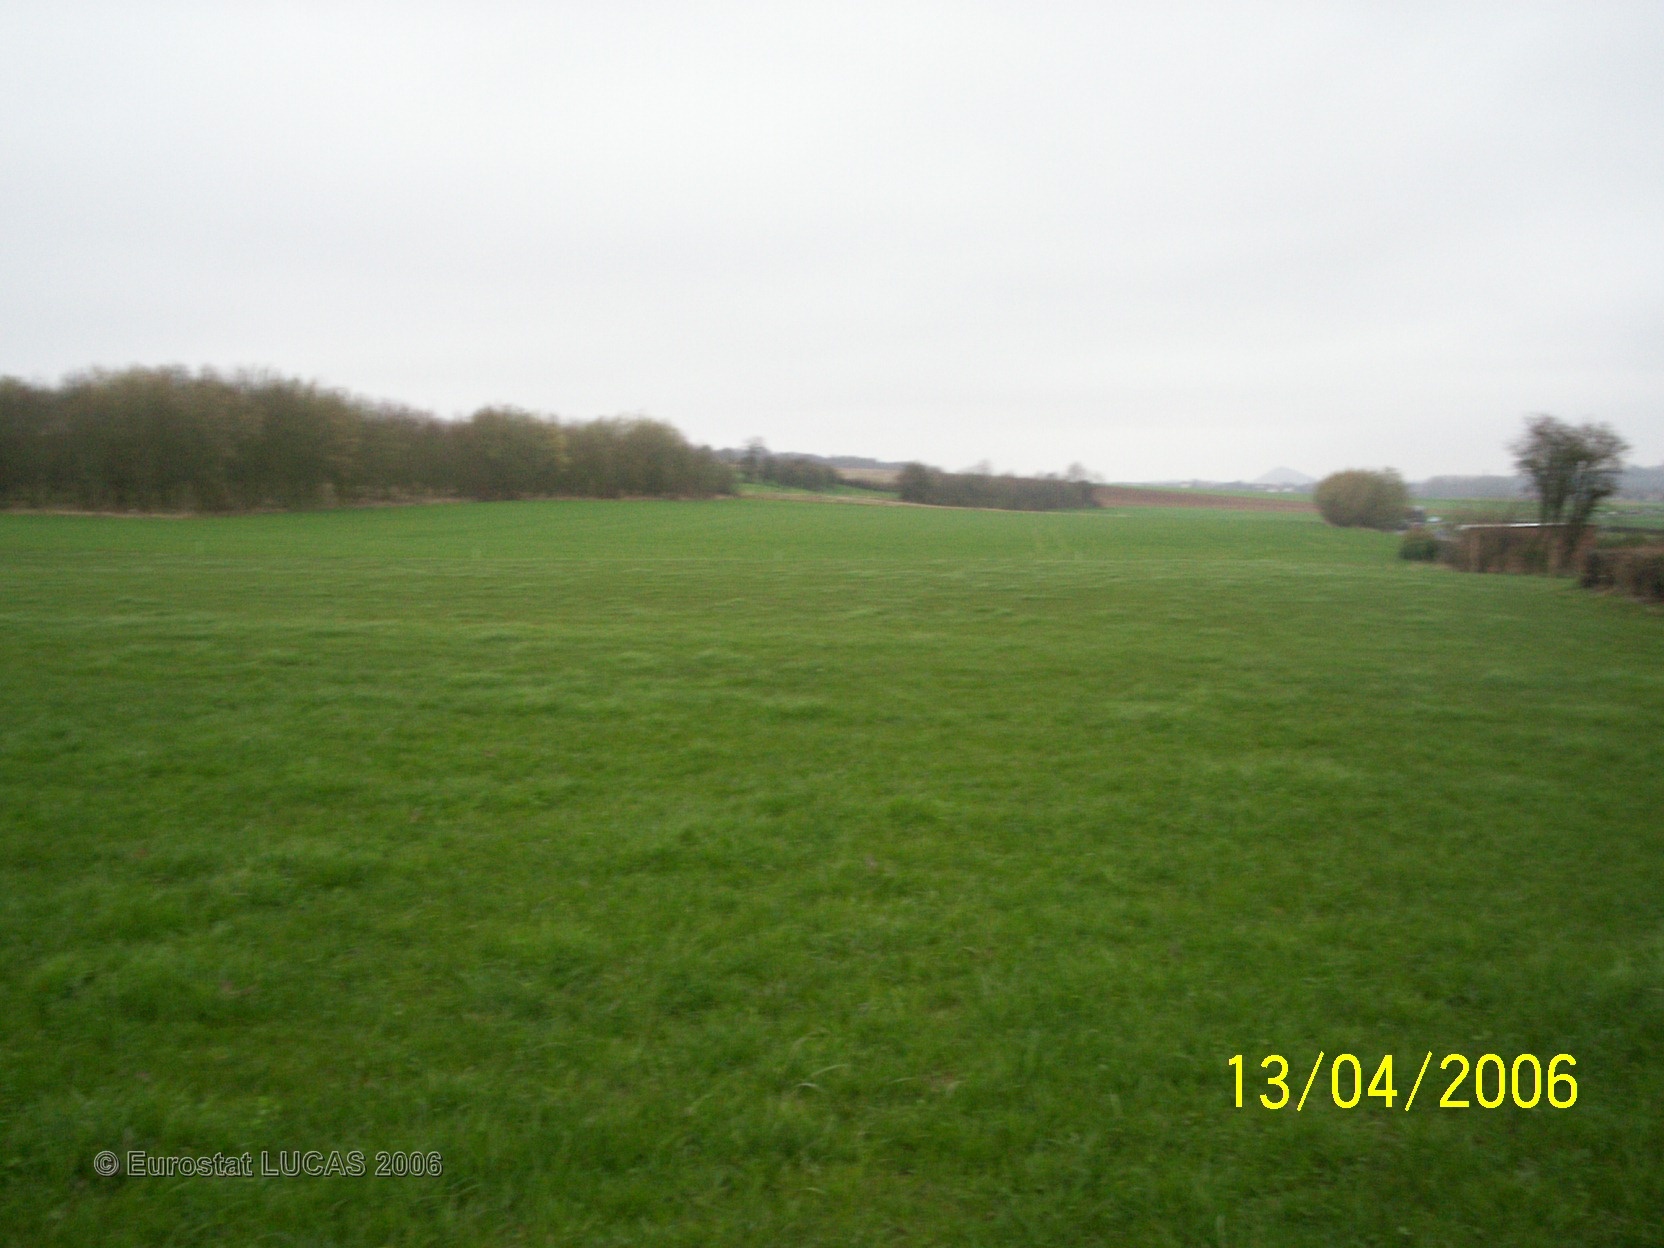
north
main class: Grassland
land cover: Grassland without tree/shrub cover
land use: Agriculture (excluding fallow land and kitchen gardens)
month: April
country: FR
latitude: 50.4397
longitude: 2.4541
